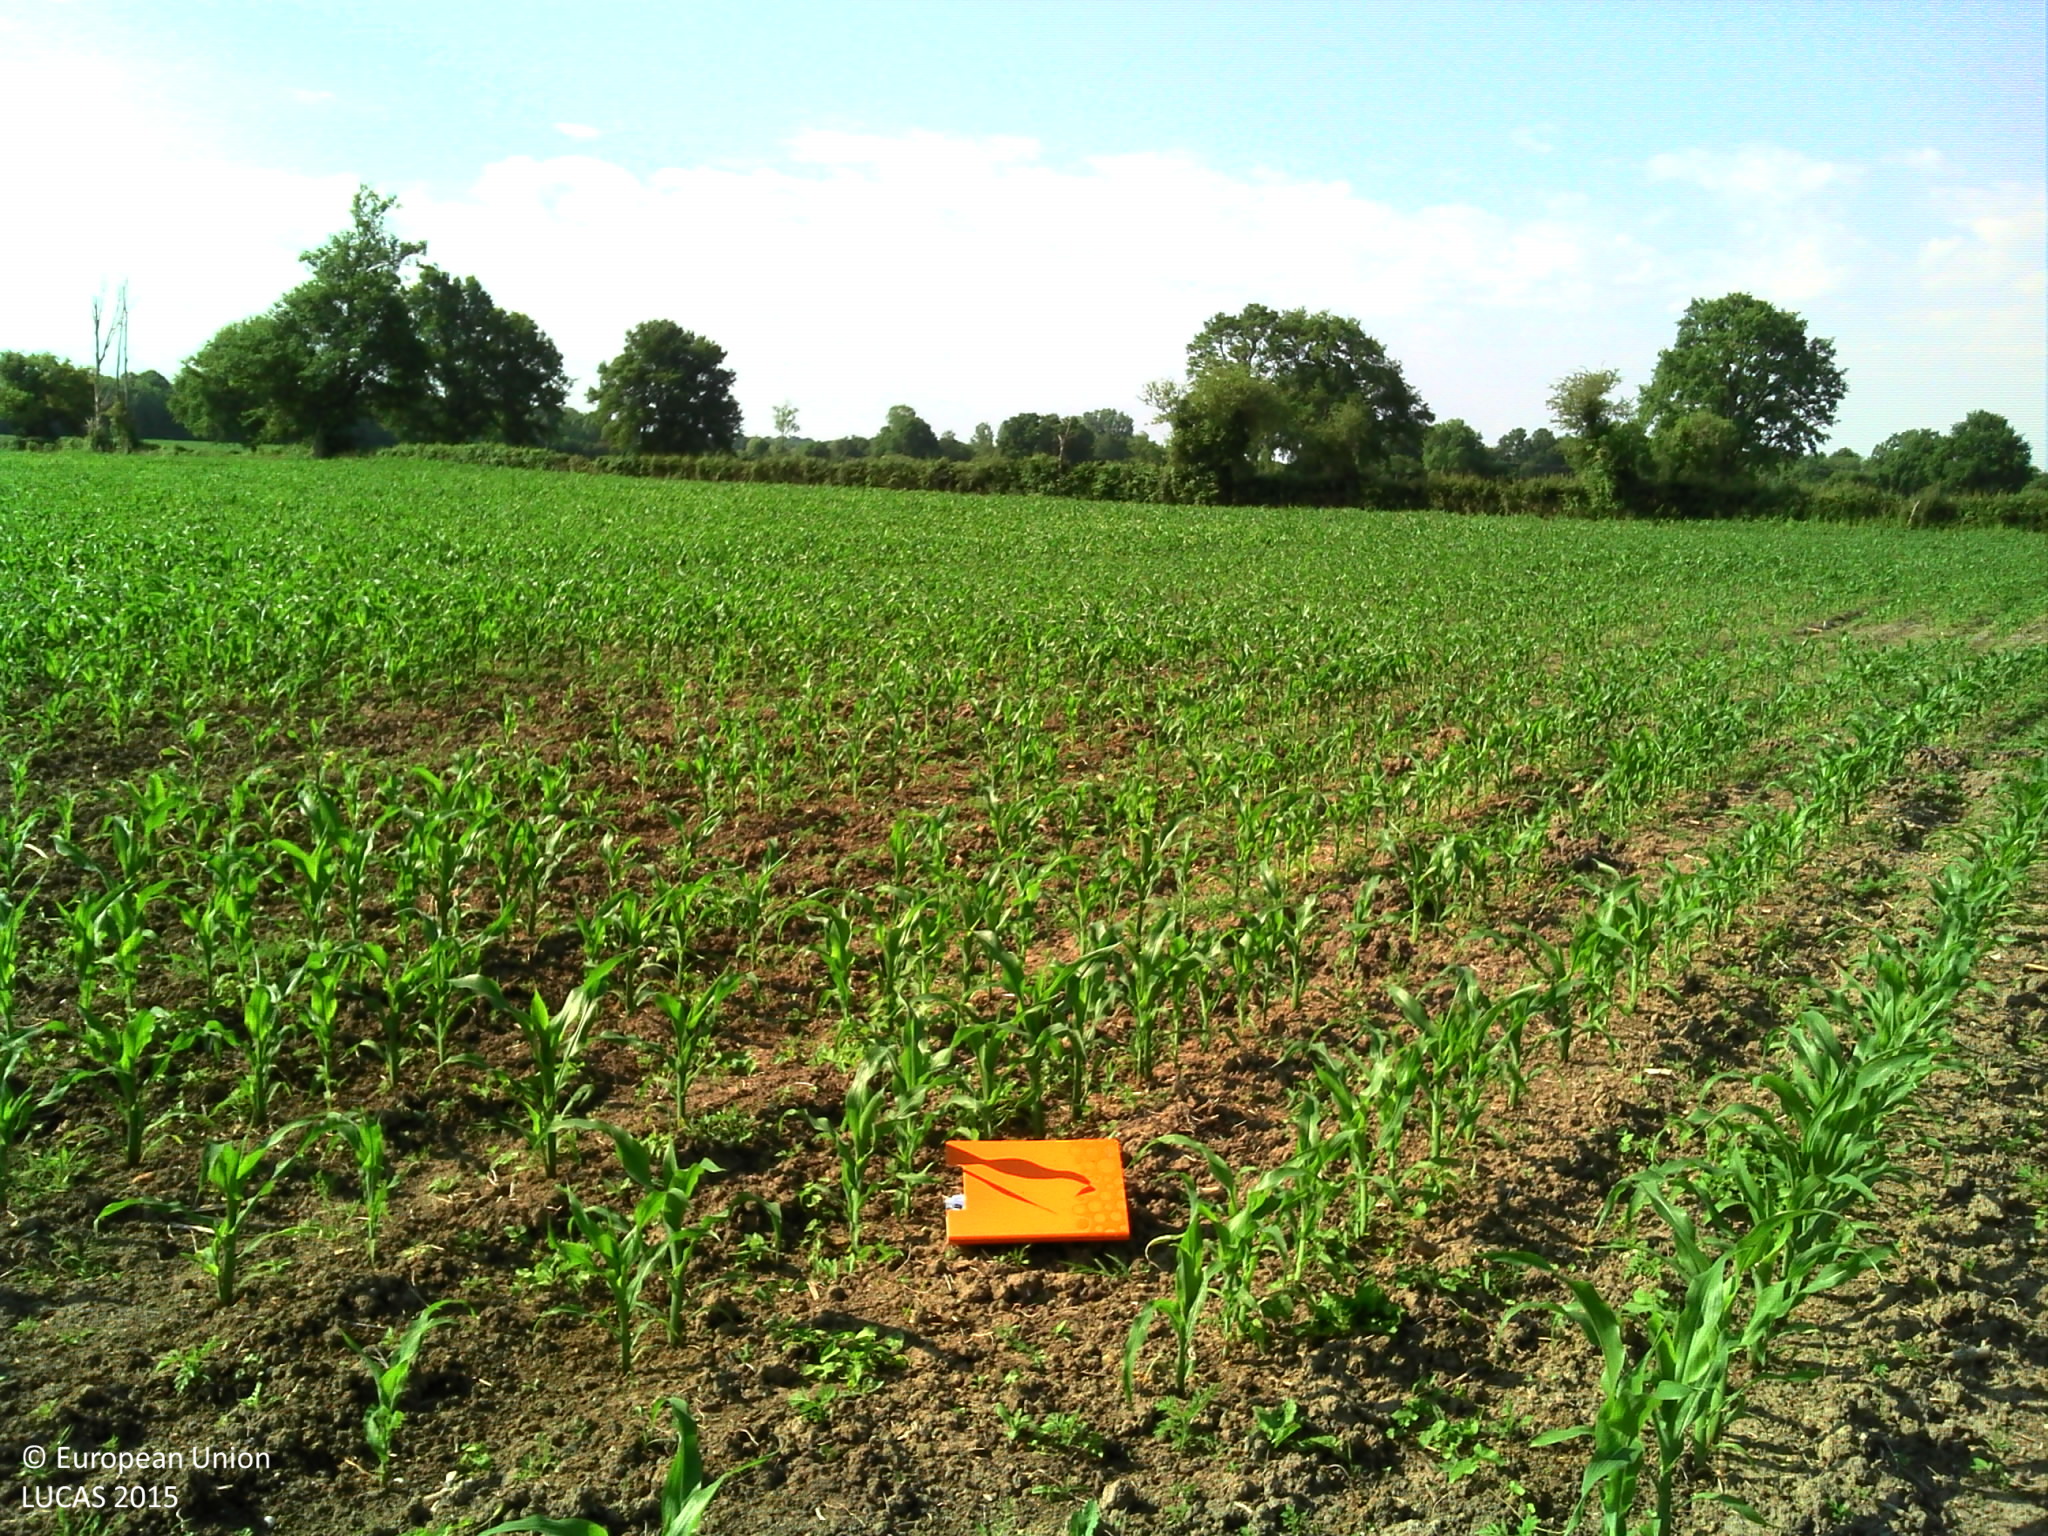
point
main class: Cropland
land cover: Maize
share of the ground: 50 - 75 %
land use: Agriculture (excluding fallow land and kitchen gardens)
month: June
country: FR
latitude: 46.7724
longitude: 2.7271
